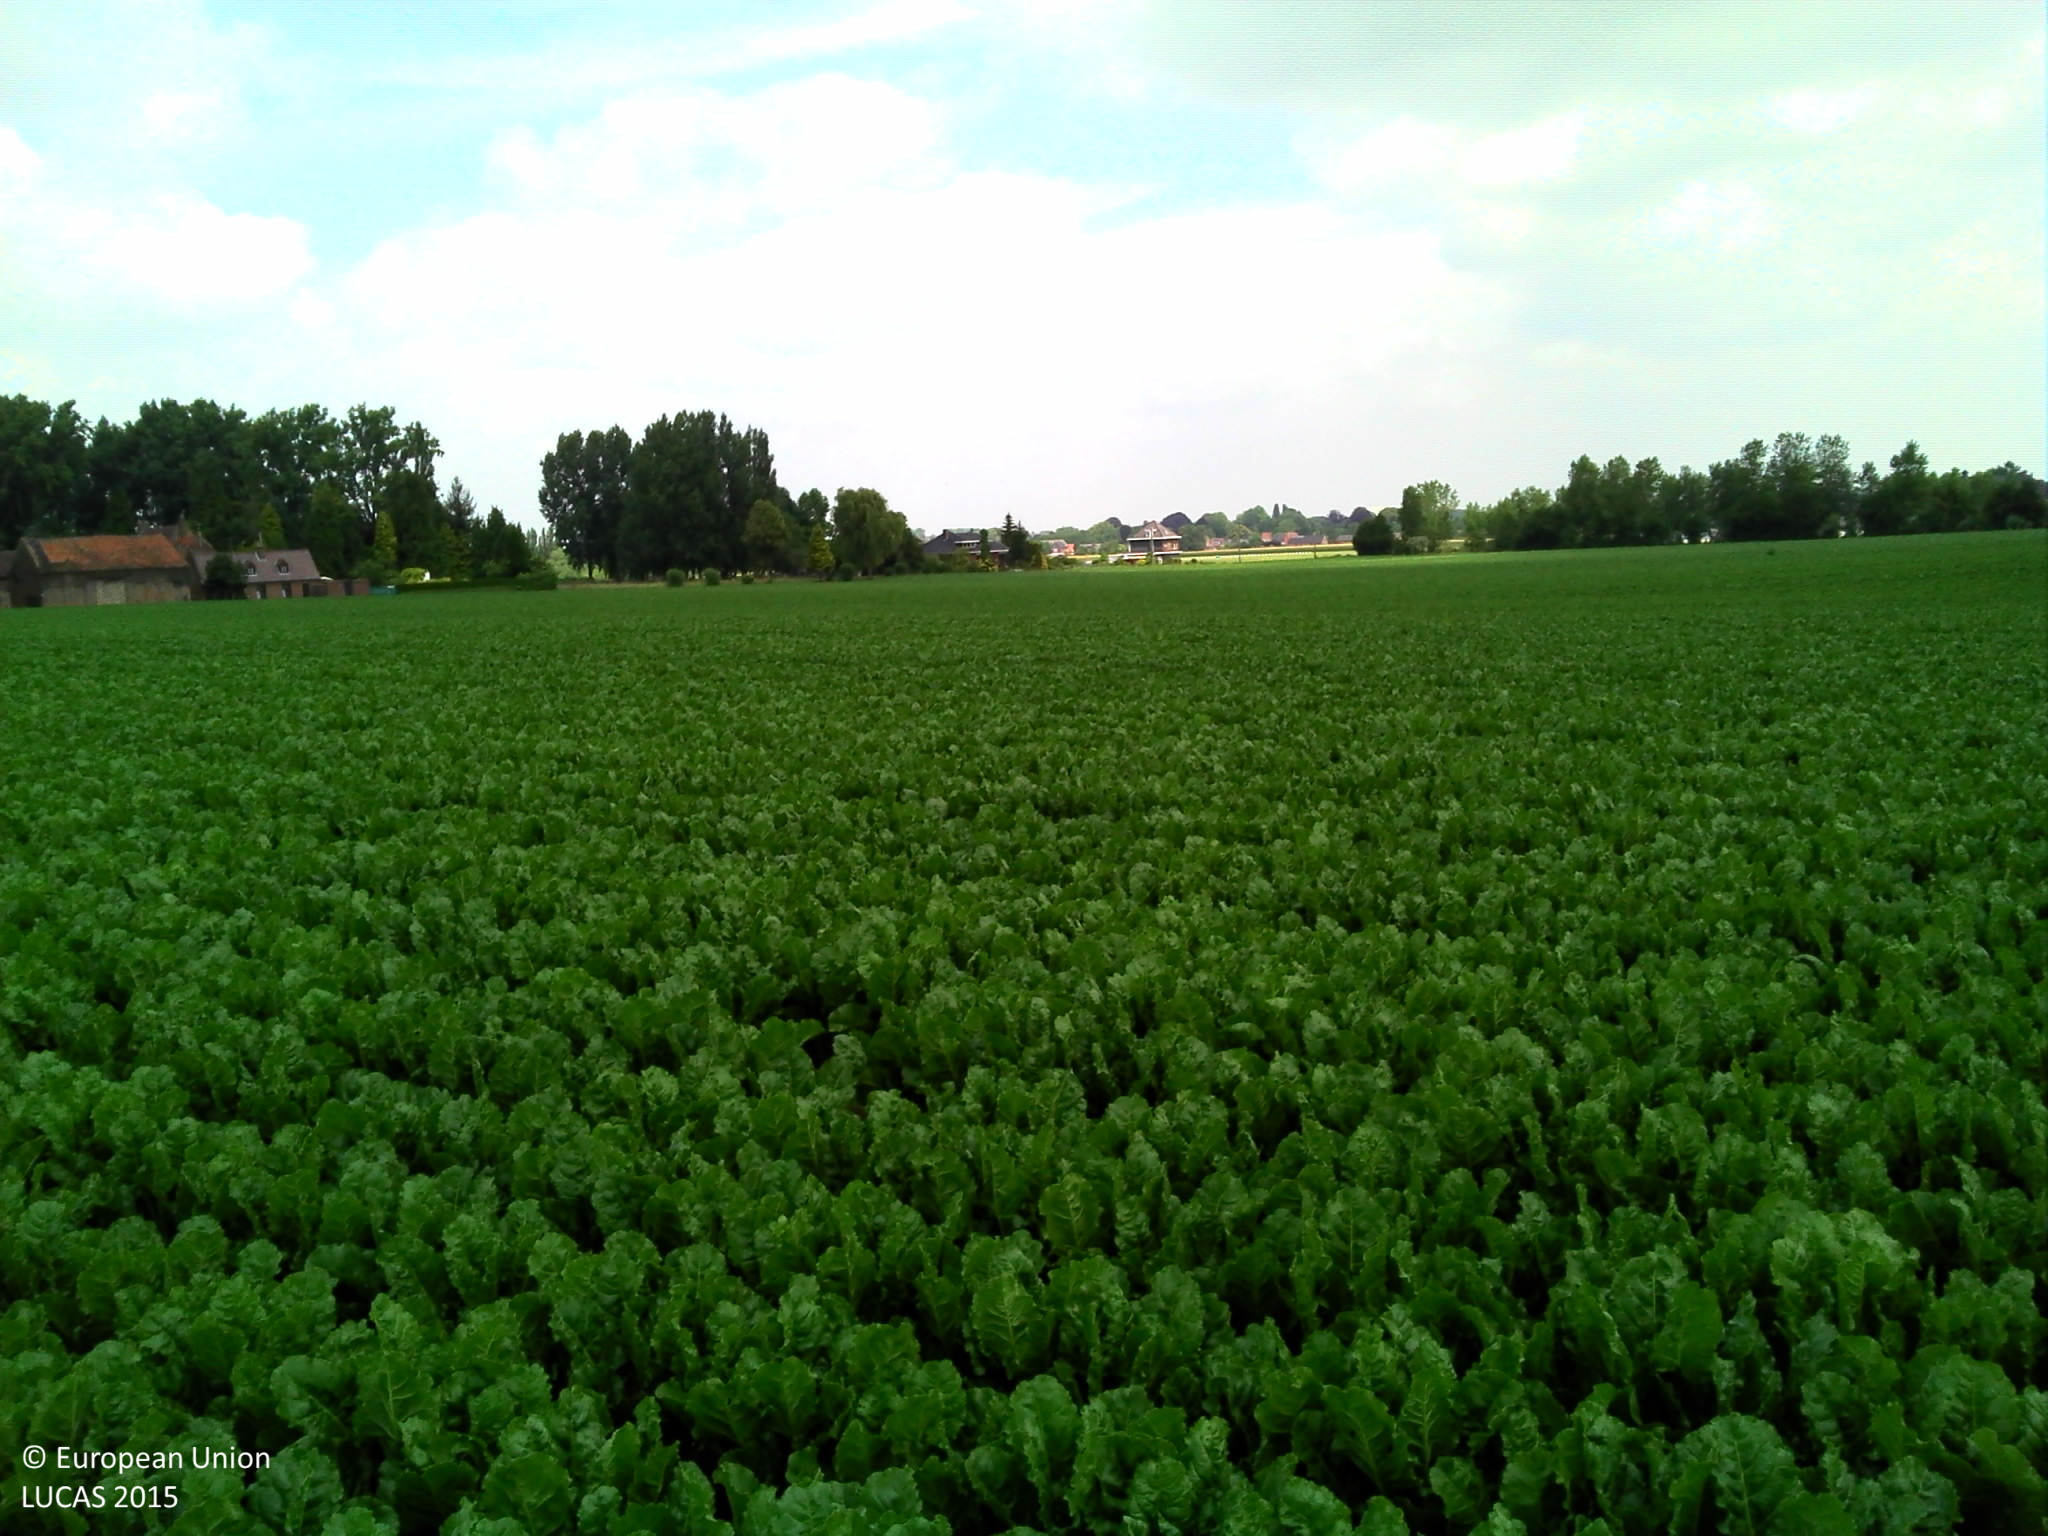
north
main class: Cropland
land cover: Sugar beet
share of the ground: > 75 %
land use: Agriculture (excluding fallow land and kitchen gardens)
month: June
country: BE
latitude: 50.6086
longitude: 3.7616
